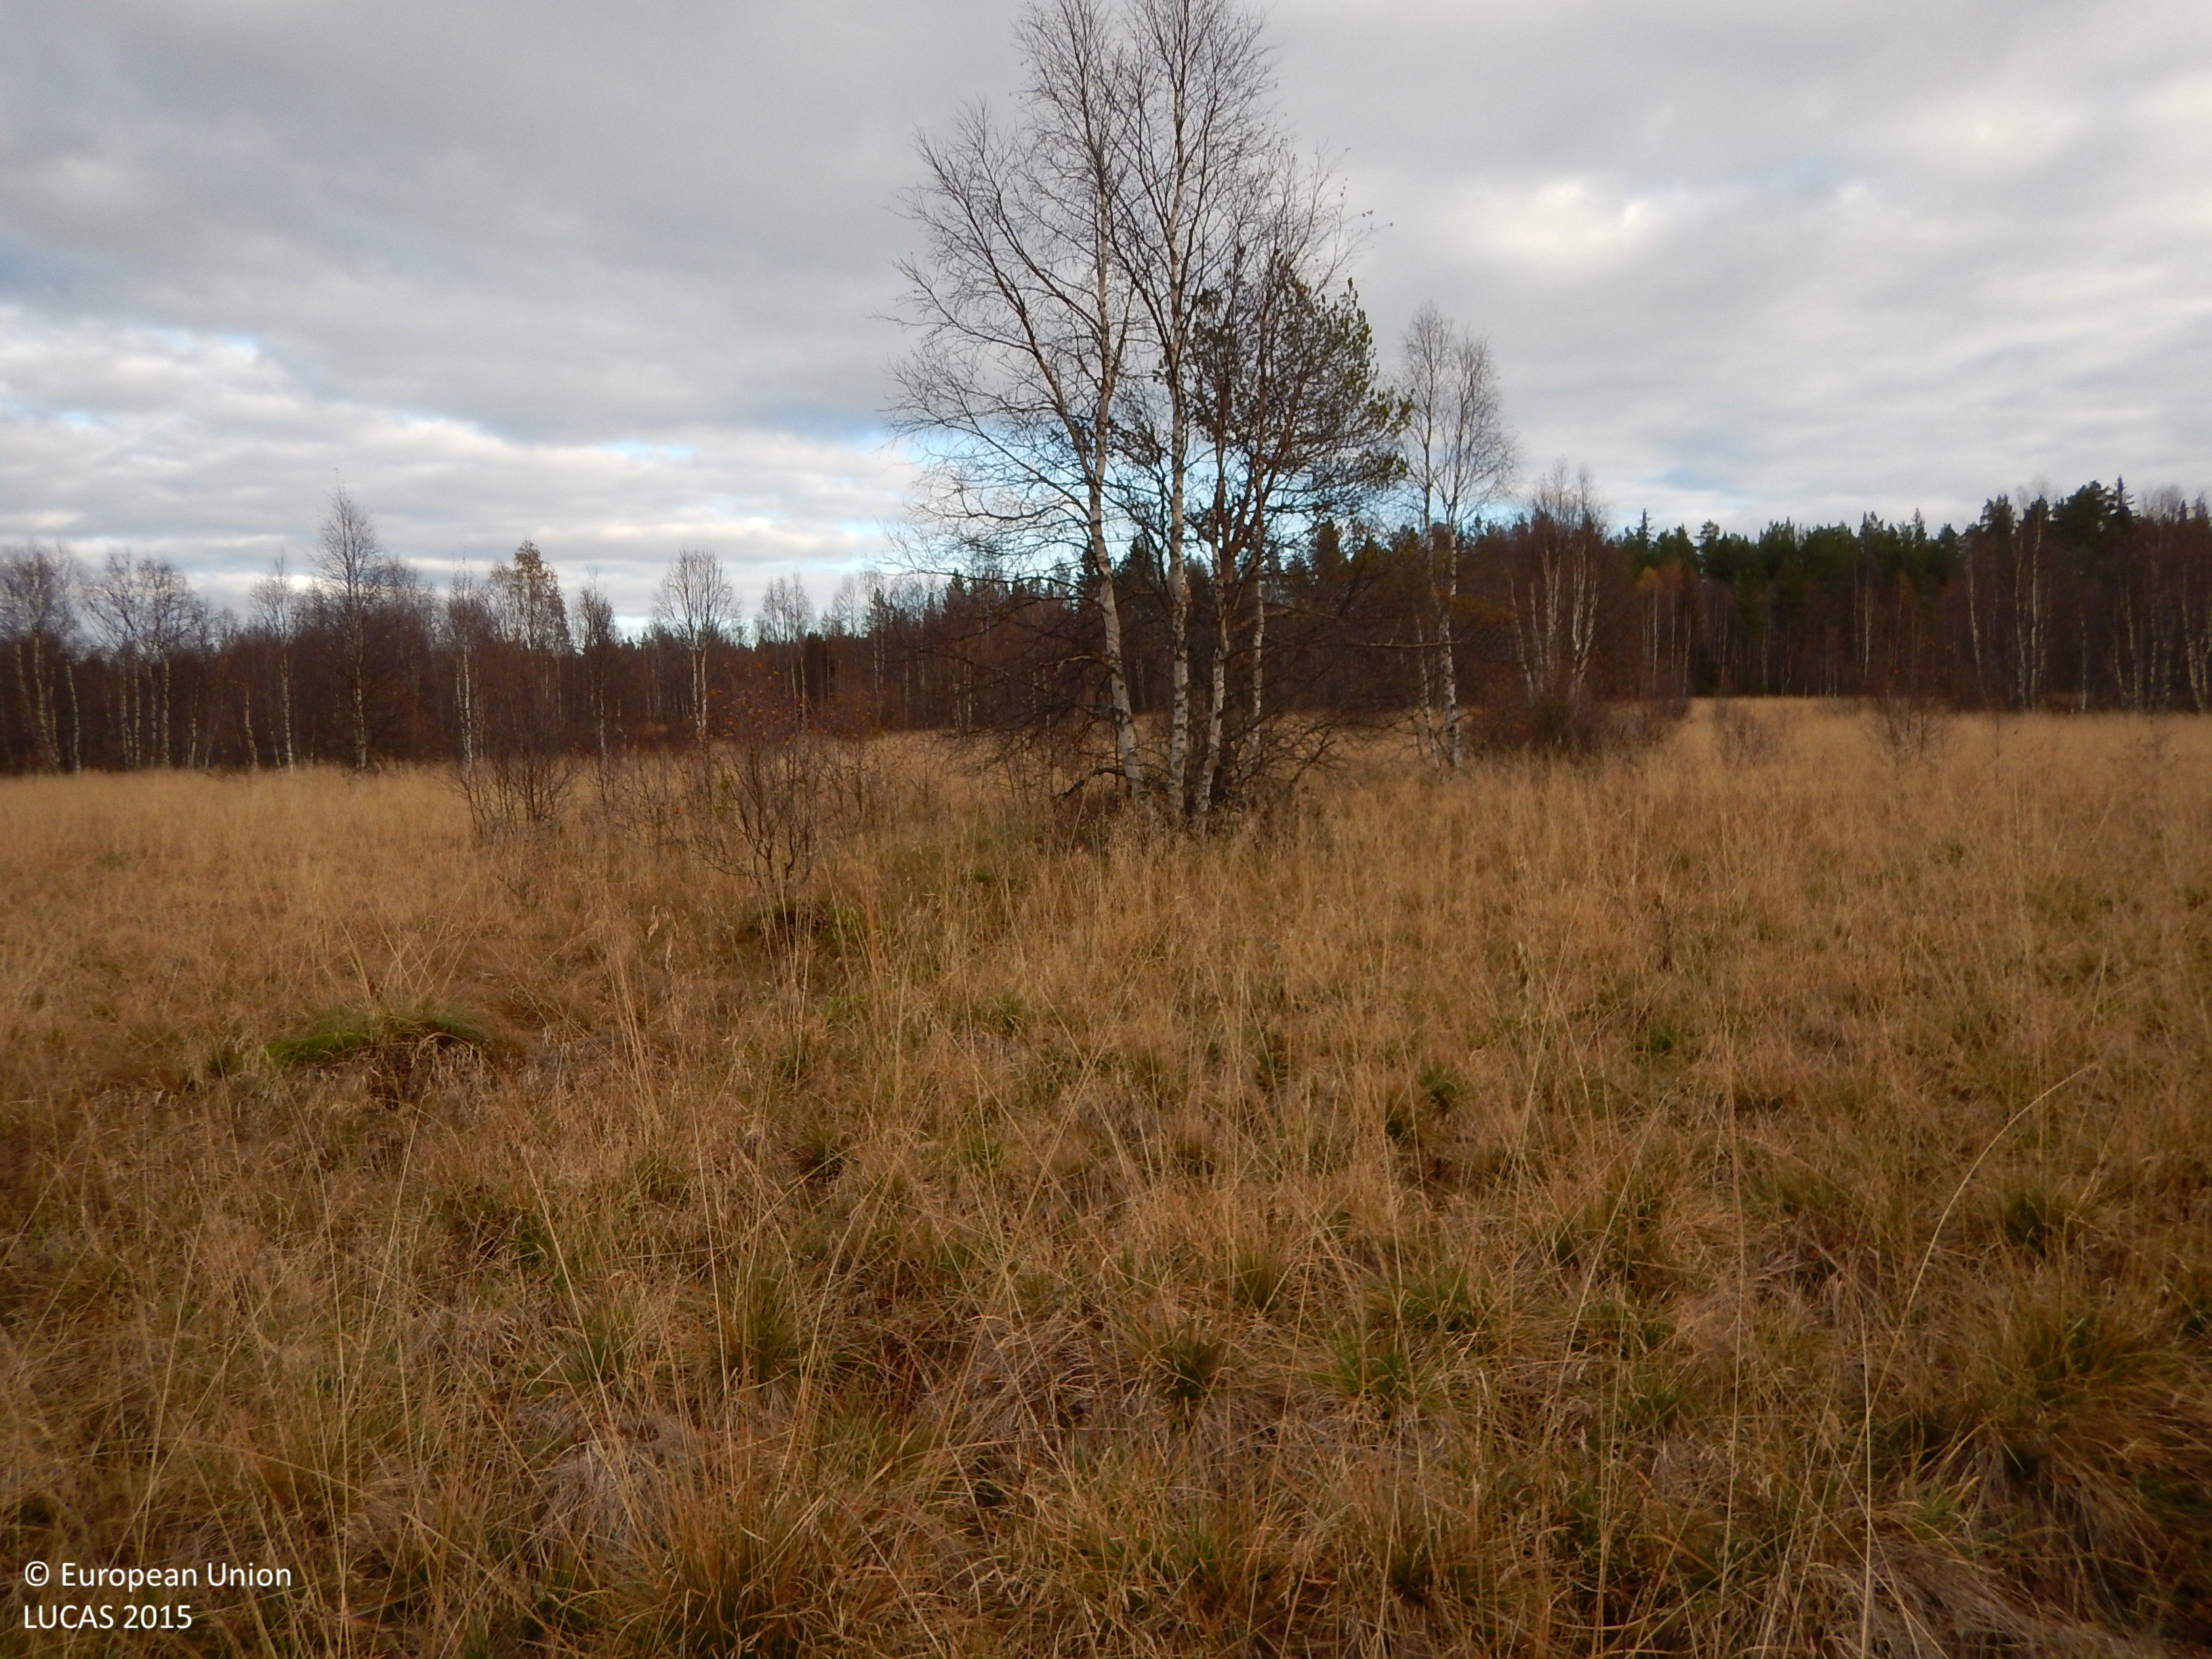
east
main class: Grassland
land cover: Grassland with sparse tree/shrub cover
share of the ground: > 75 %
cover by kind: herbaceous plants 70 %, lichens and mosses 20 %, broadleaved forest trees 5 %, shrubs 5 %
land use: Abandoned areas
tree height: > 5 m
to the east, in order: Grassland with sparse tree/shrub cover; Ditches and canals; Grassland with sparse tree/shrub cover; Broadleaved woodland; Rivers and streams; Abandoned hedges; Tracks; Abandoned hedges; Ditches and canals; Broadleaved woodland; Grassland with sparse tree/shrub cover; Spruce dominated mixed woodland
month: October
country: SE
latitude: 65.1274
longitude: 21.0336
